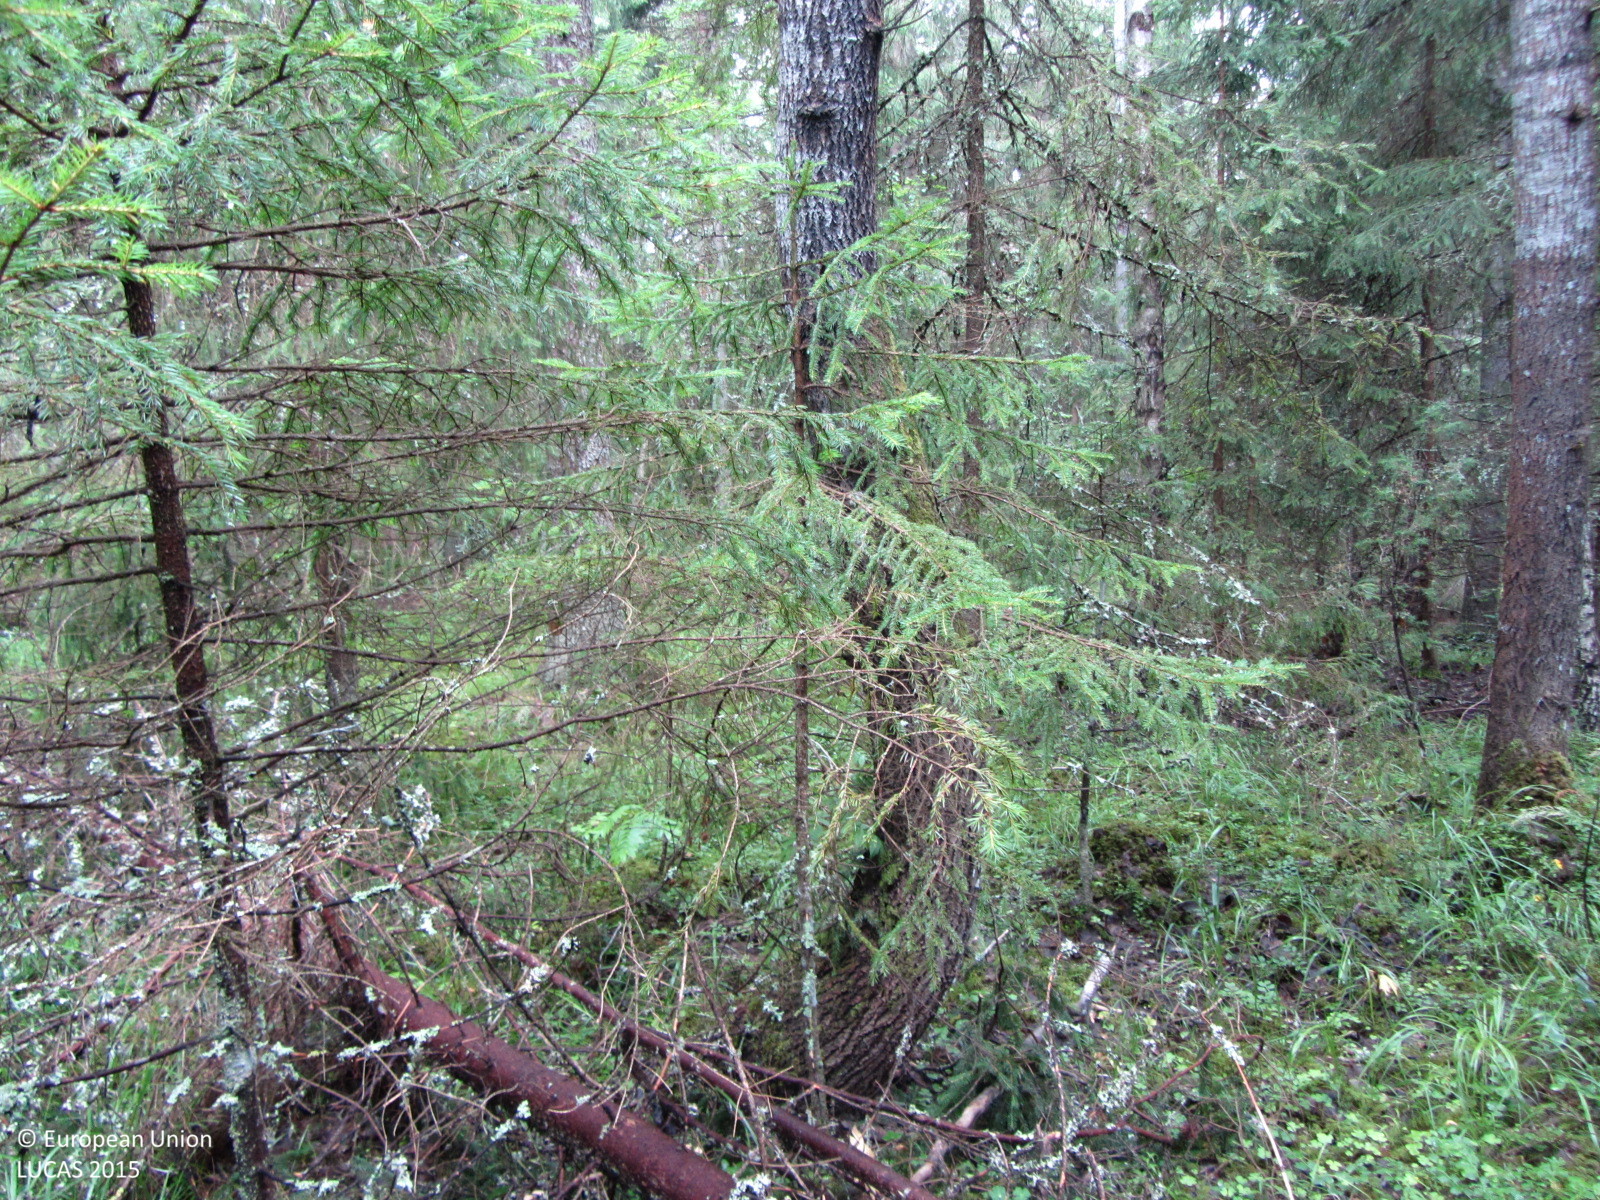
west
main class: Woodland
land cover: Spruce dominated mixed woodland
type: boreal forest
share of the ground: > 75 %
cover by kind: coniferous forest trees 60 %, broadleaved forest trees 20 %, lichens and mosses 10 %, shrubs 5 %, herbaceous plants 5 %
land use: Forestry
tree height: > 5 m
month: July
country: FI
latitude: 60.4870
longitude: 24.3525
